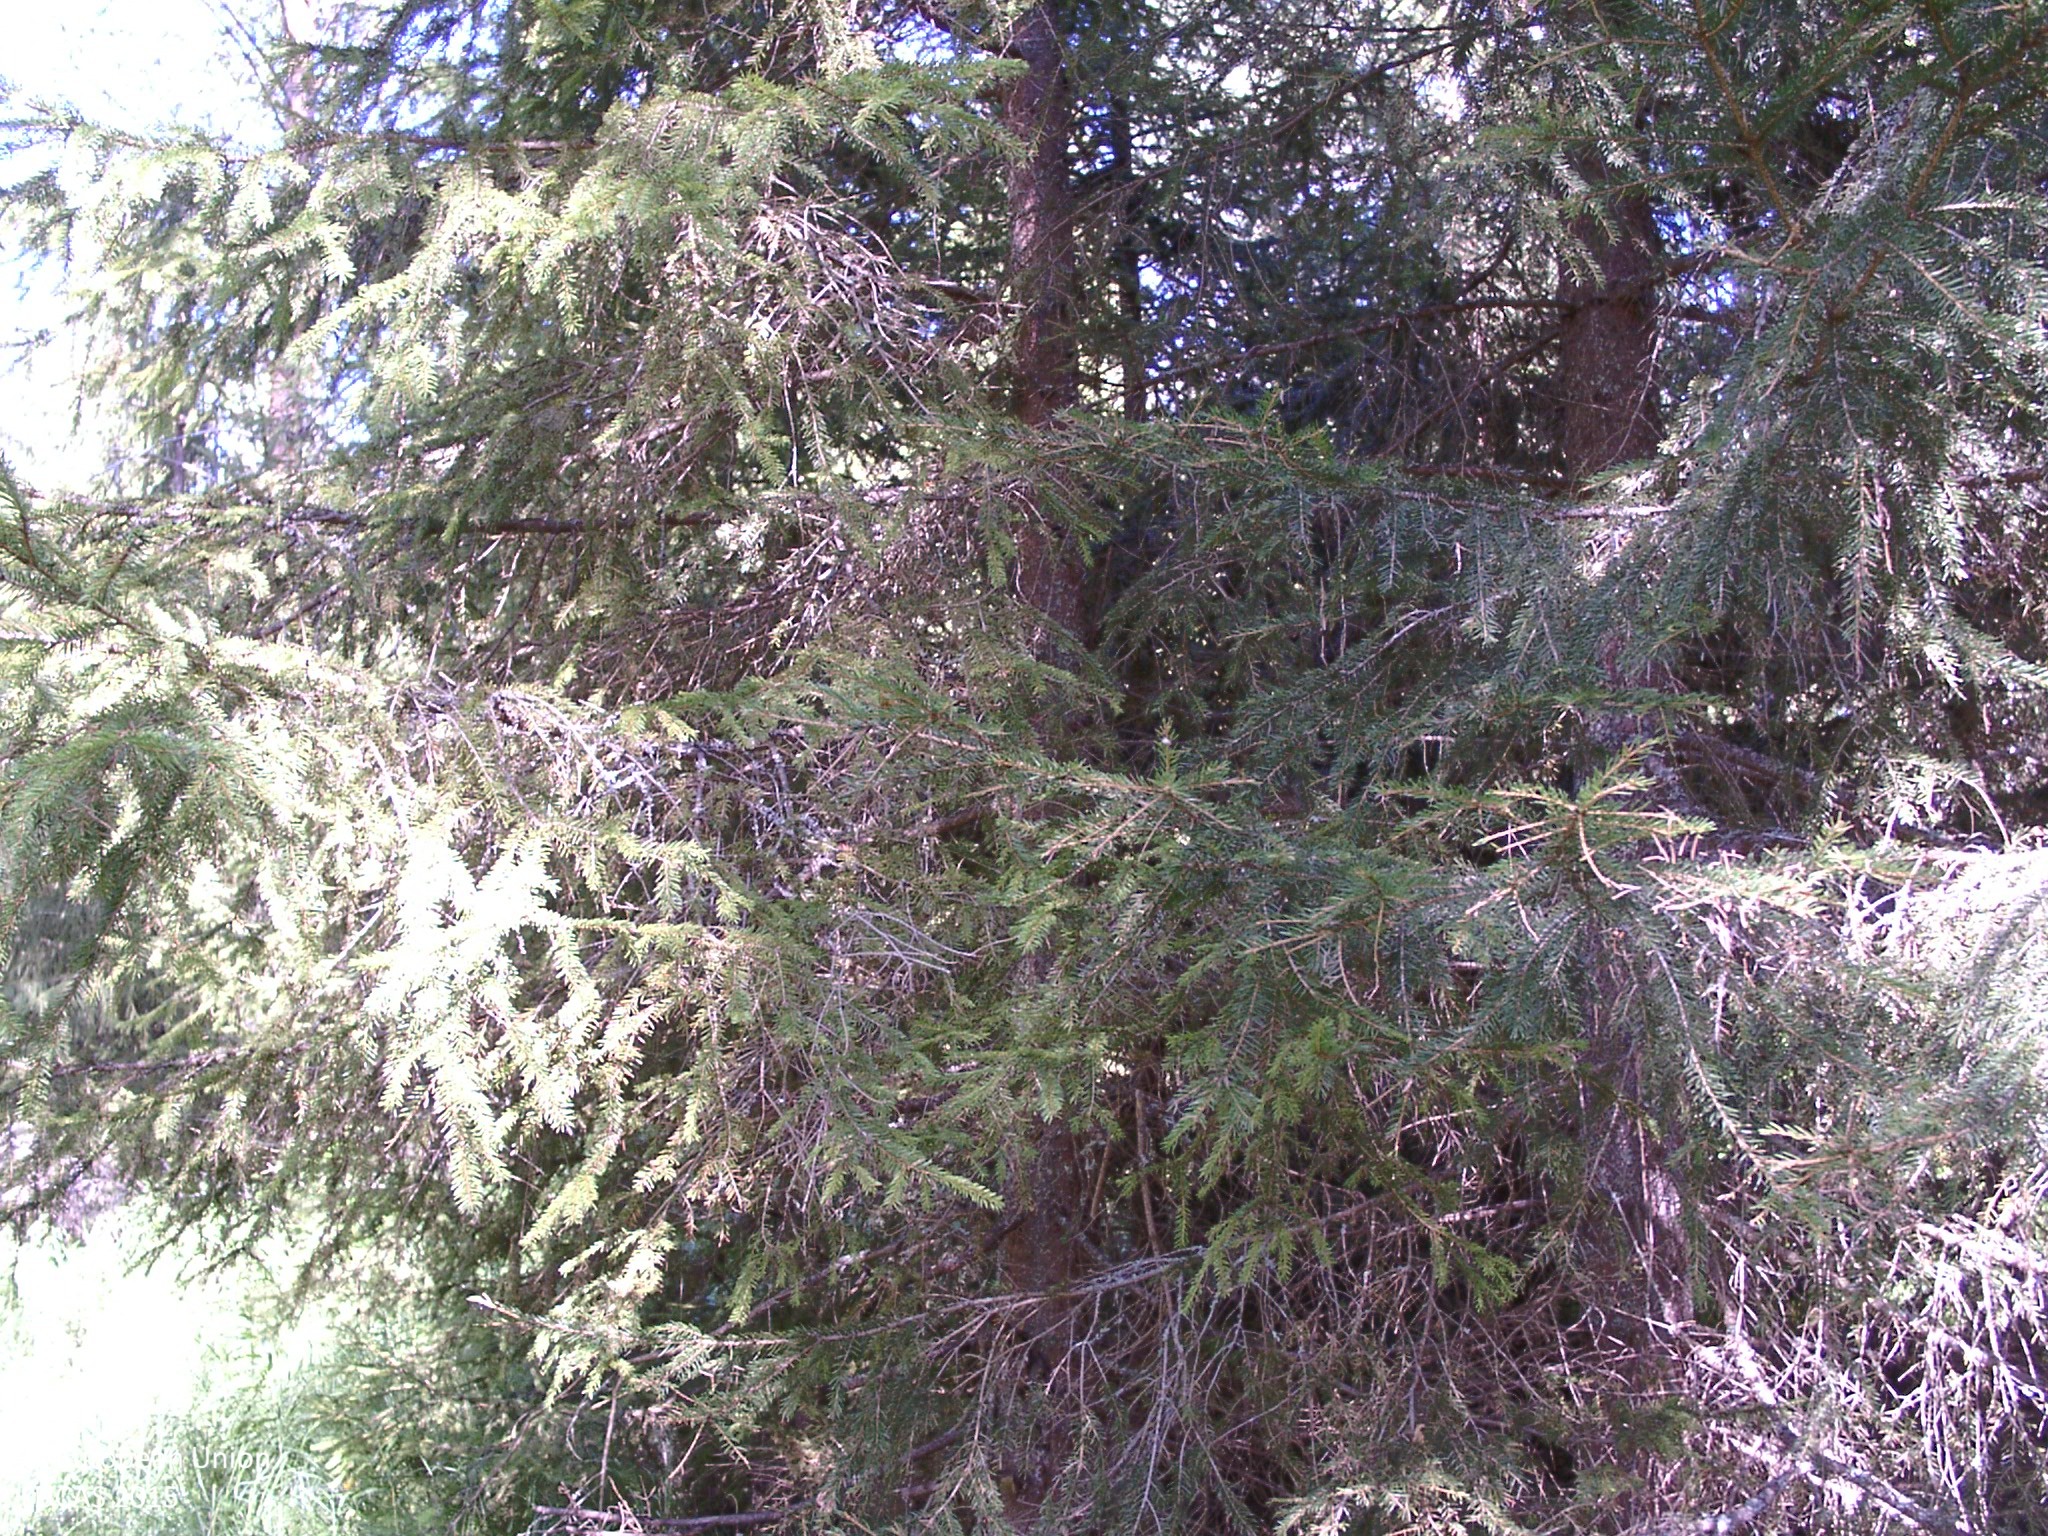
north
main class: Woodland
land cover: Other mixed woodland
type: boreal forest
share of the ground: 50 - 75 %
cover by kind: herbaceous plants 40 %, coniferous forest trees 30 %, broadleaved forest trees 30 %
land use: Forestry
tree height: > 5 m
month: August
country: FI
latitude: 61.9689
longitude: 24.9633
